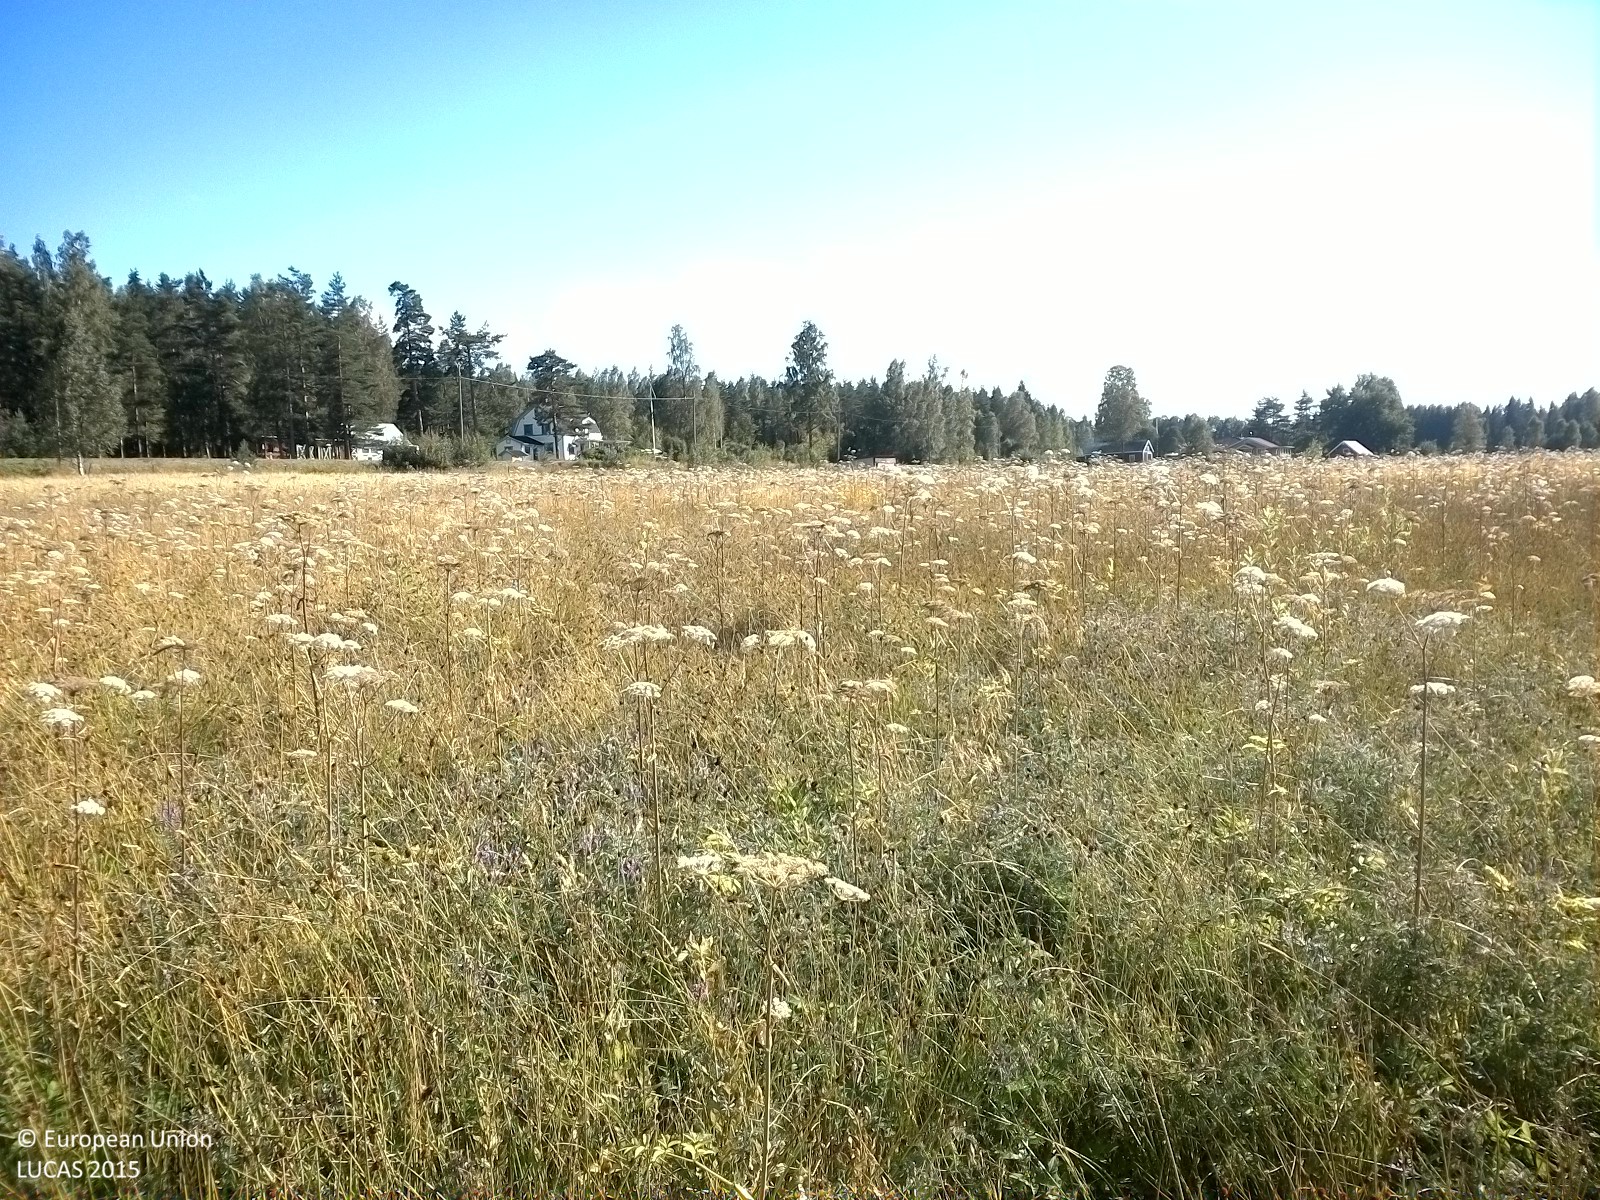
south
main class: Grassland
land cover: Grassland without tree/shrub cover
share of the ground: > 75 %
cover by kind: herbaceous plants 100 %
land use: Agriculture (excluding fallow land and kitchen gardens)
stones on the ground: < 10 %
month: August
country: SE
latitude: 59.3178
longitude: 14.9636
